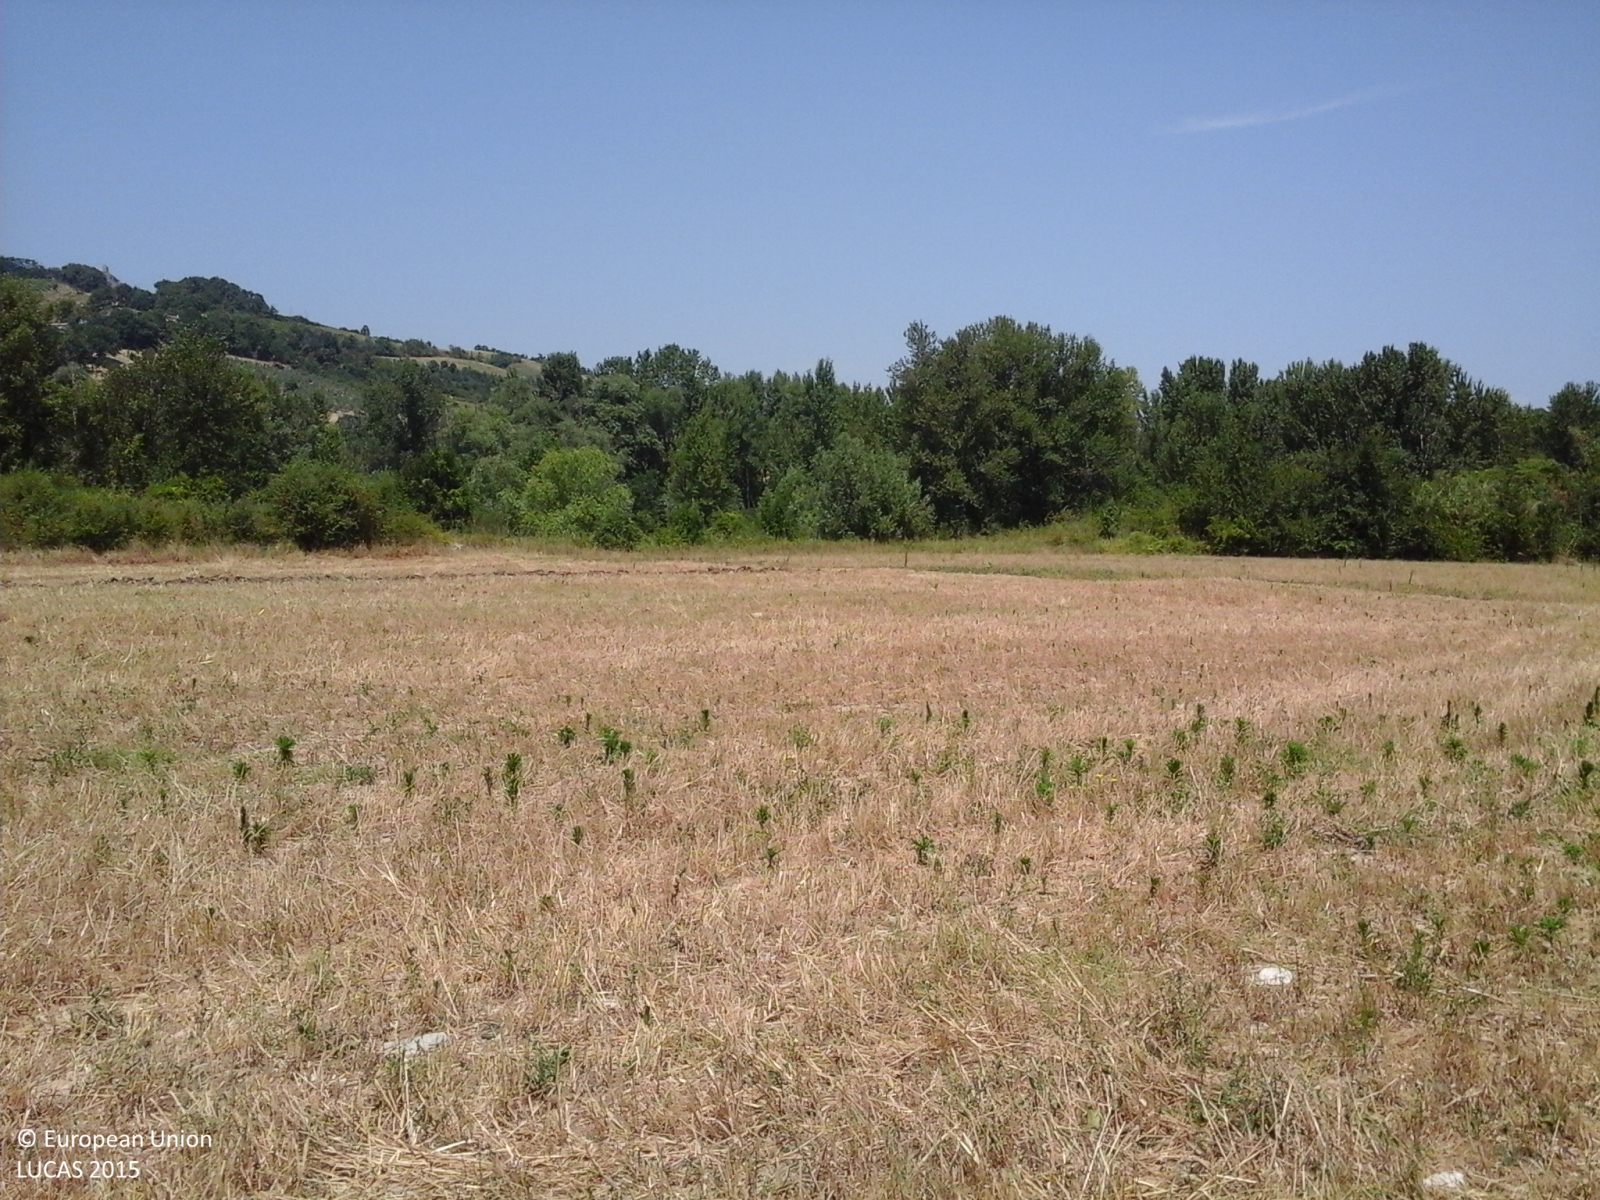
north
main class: Cropland
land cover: Barley
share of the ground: > 75 %
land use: Agriculture (excluding fallow land and kitchen gardens)
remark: Harvested field
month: July
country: IT
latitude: 43.9619
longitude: 12.3997
